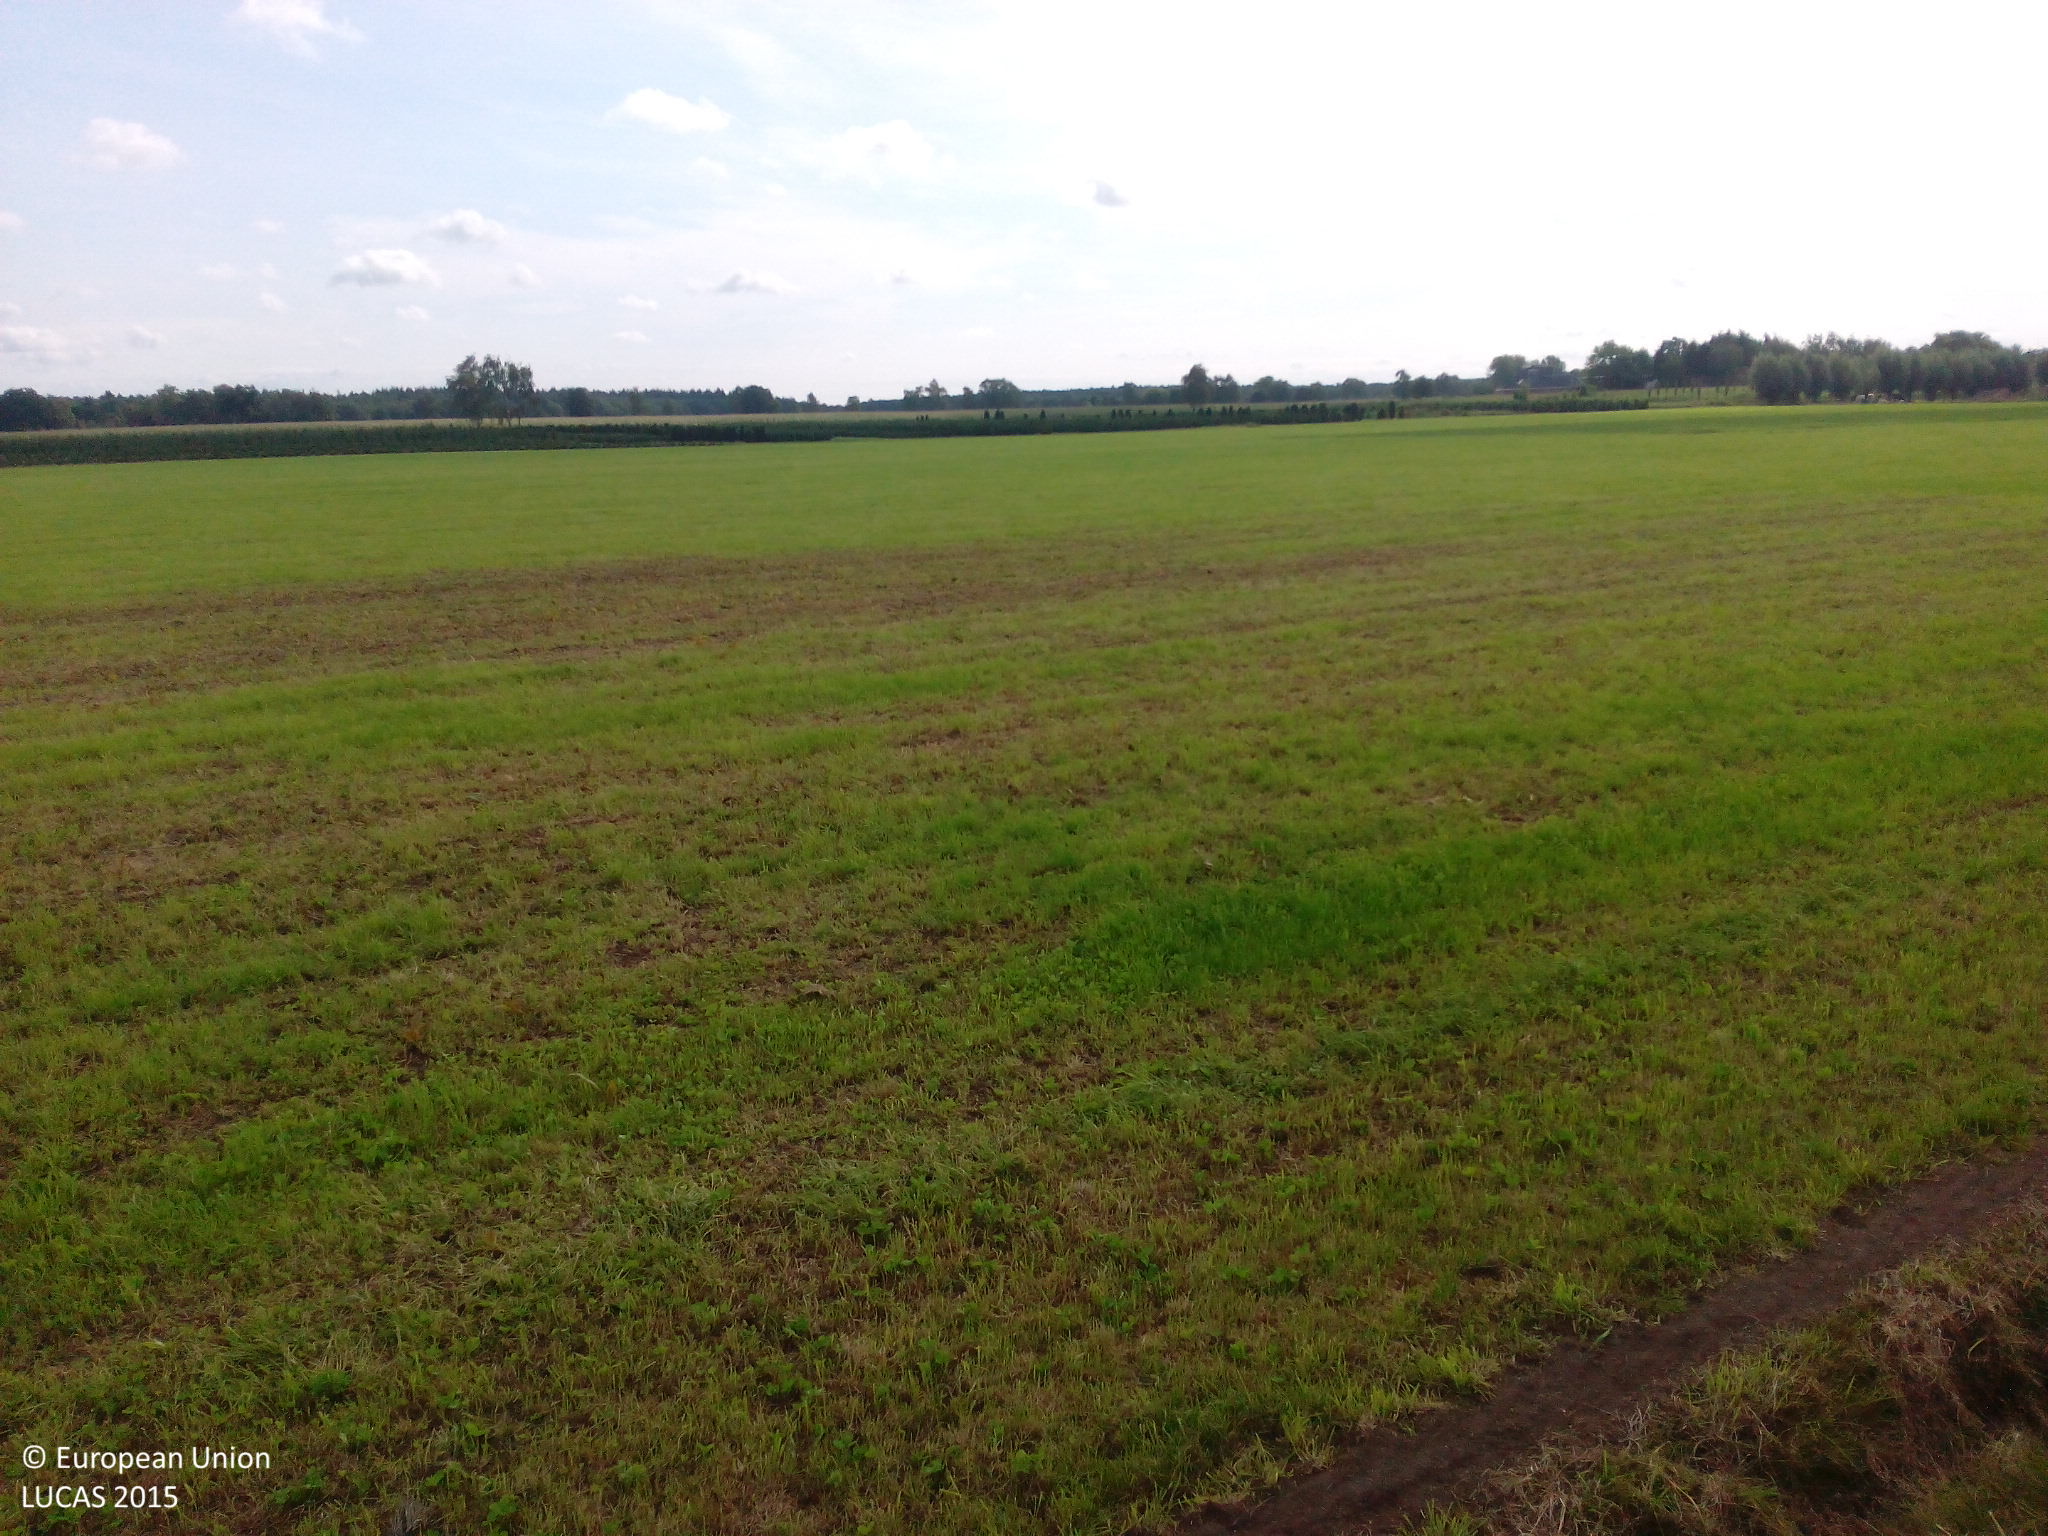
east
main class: Grassland
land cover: Grassland without tree/shrub cover
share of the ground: > 75 %
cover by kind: herbaceous plants 100 %
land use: Agriculture (excluding fallow land and kitchen gardens)
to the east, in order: Grassland without tree/shrub cover; Ditches and canals; Nurseries; Tracks; Grass margins; Ditches and canals; Grass margins; Paved roads, cycling and walking lanes; Grass margins; Ditches and canals; Maize
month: August
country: NL
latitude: 51.3246
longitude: 5.6215
